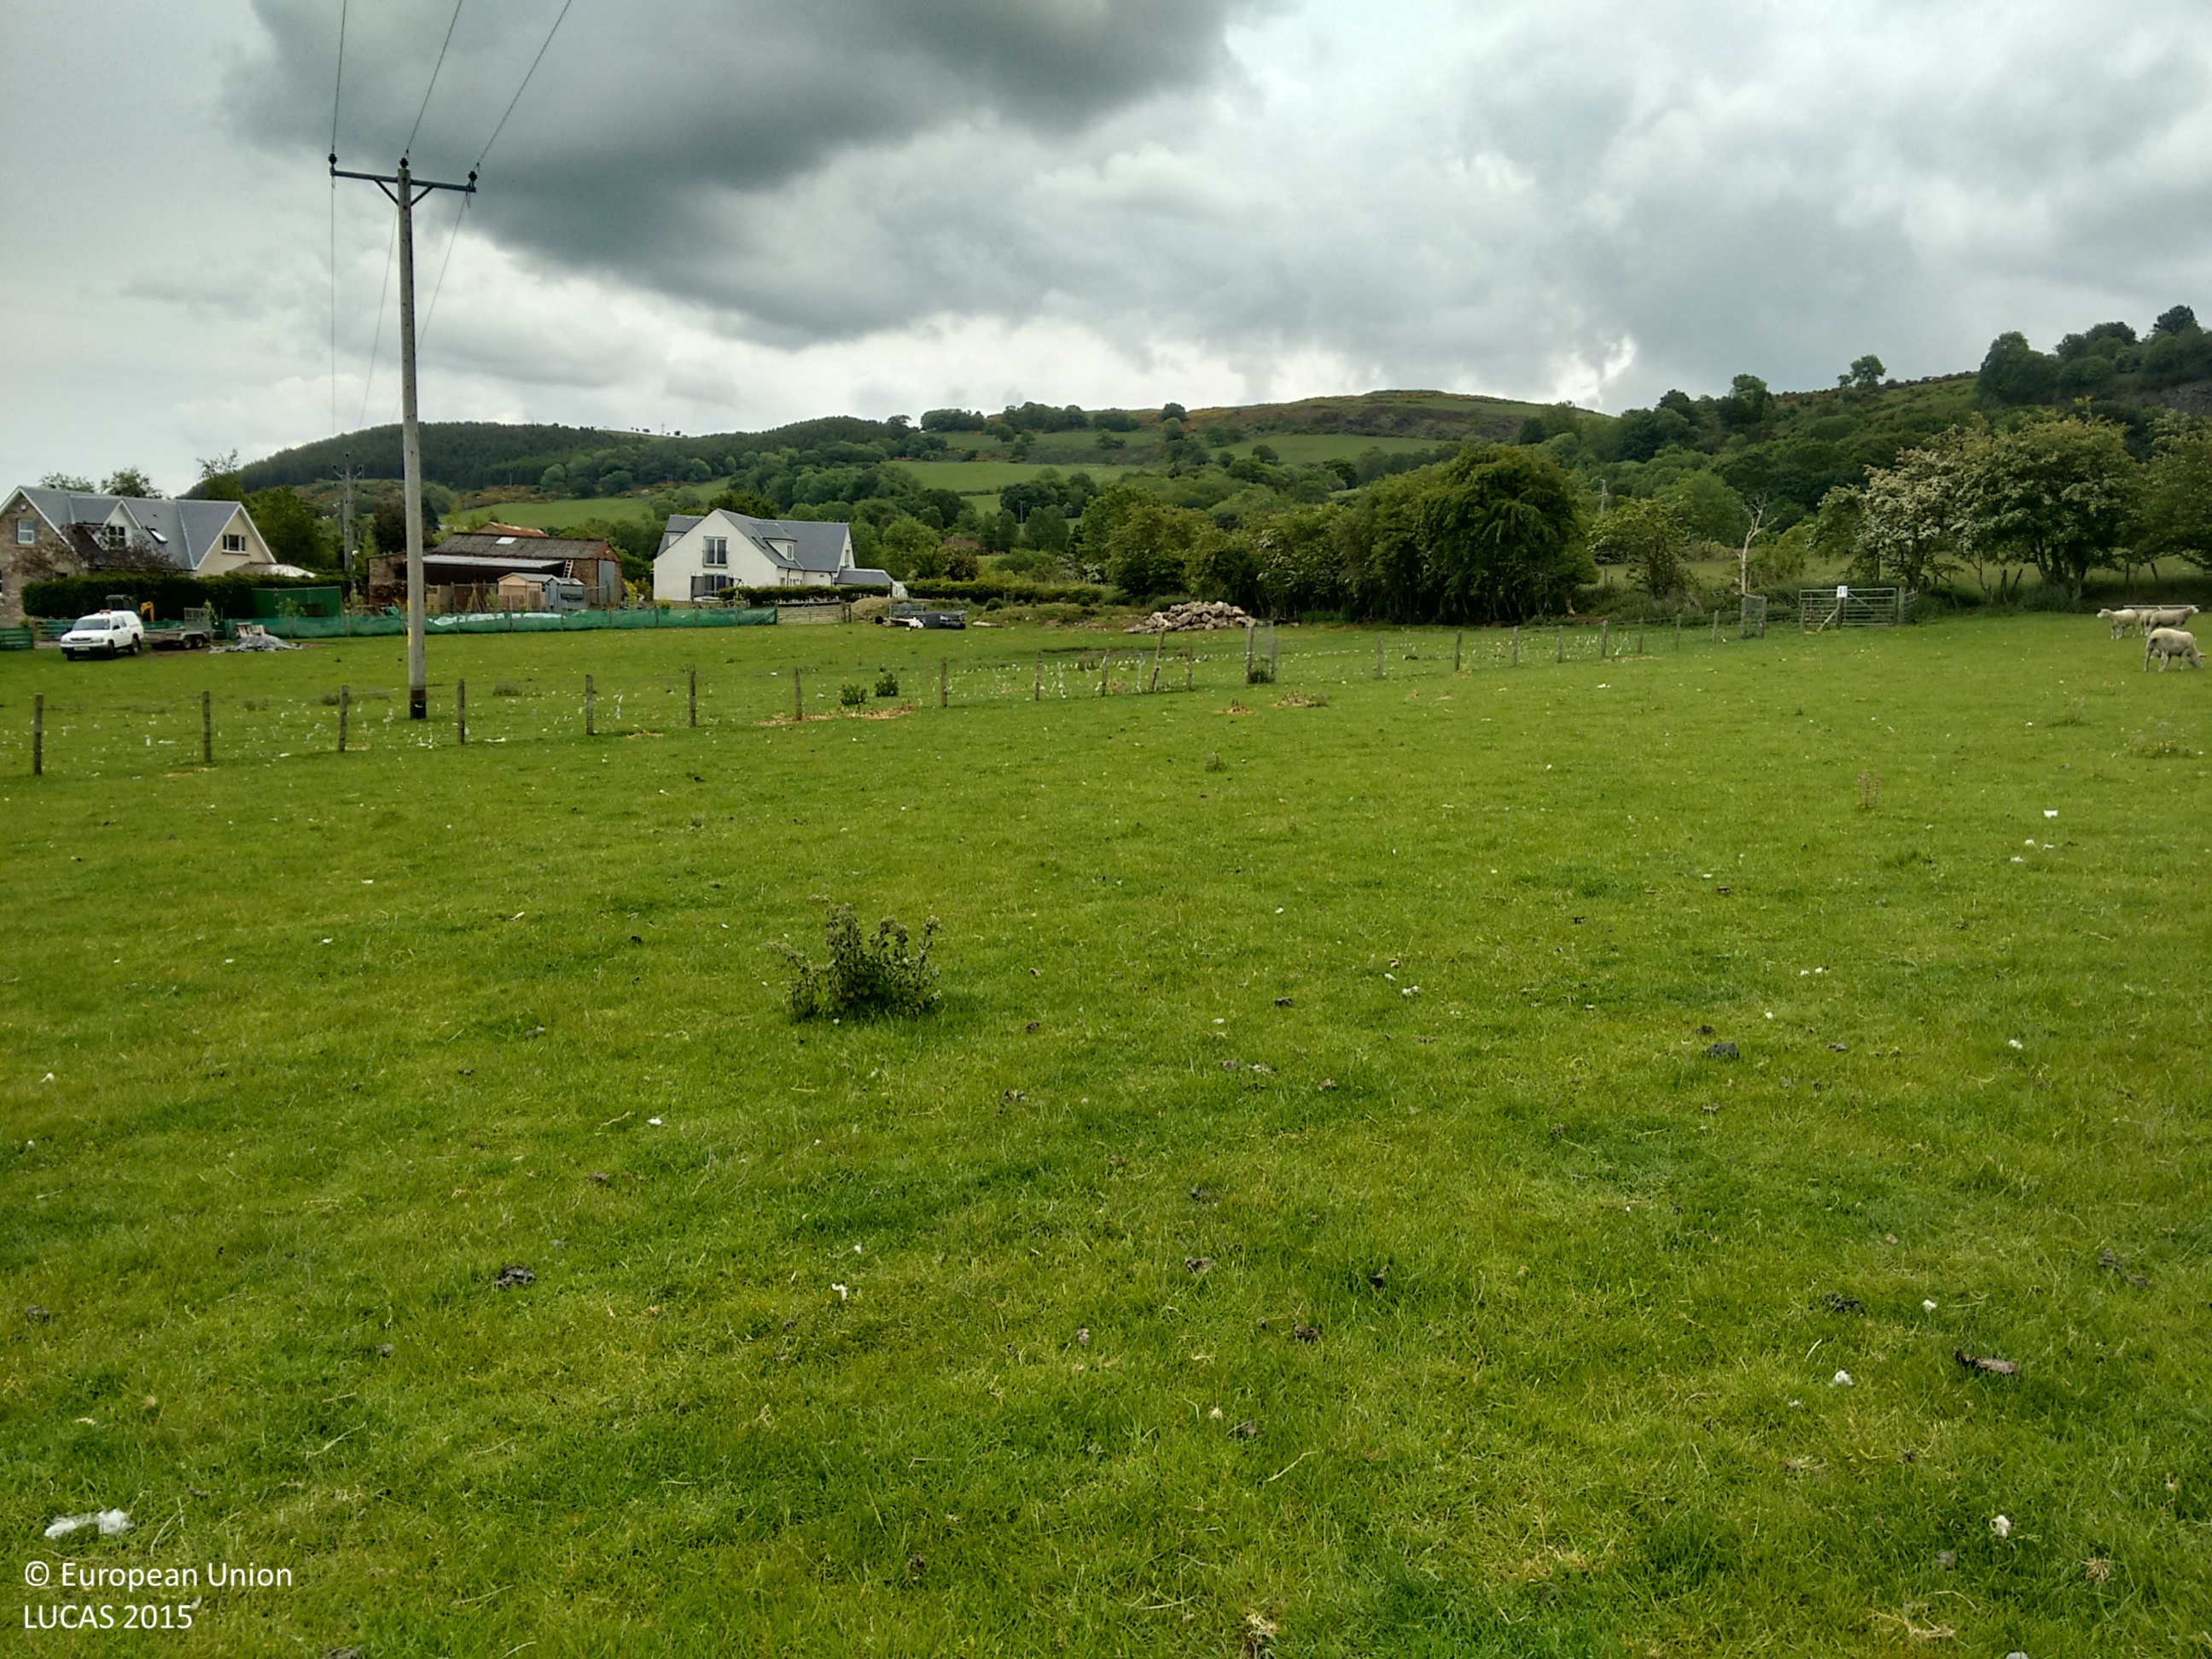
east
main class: Grassland
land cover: Grassland without tree/shrub cover
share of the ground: > 75 %
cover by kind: herbaceous plants 100 %
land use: Agriculture (excluding fallow land and kitchen gardens)
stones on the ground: < 10 %
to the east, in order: Grassland without tree/shrub cover; Electric lines; Grassland without tree/shrub cover; Fences; Grassland without tree/shrub cover; Fences; Grassland without tree/shrub cover; Artificial constructions in urban areas; Lines of trees; Tracks; Abandoned hedges; Fences; Grassland without tree/shrub cover; Electric lines; Grassland without tree/shrub cover
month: June
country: GB
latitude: 56.3291
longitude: -3.3177
